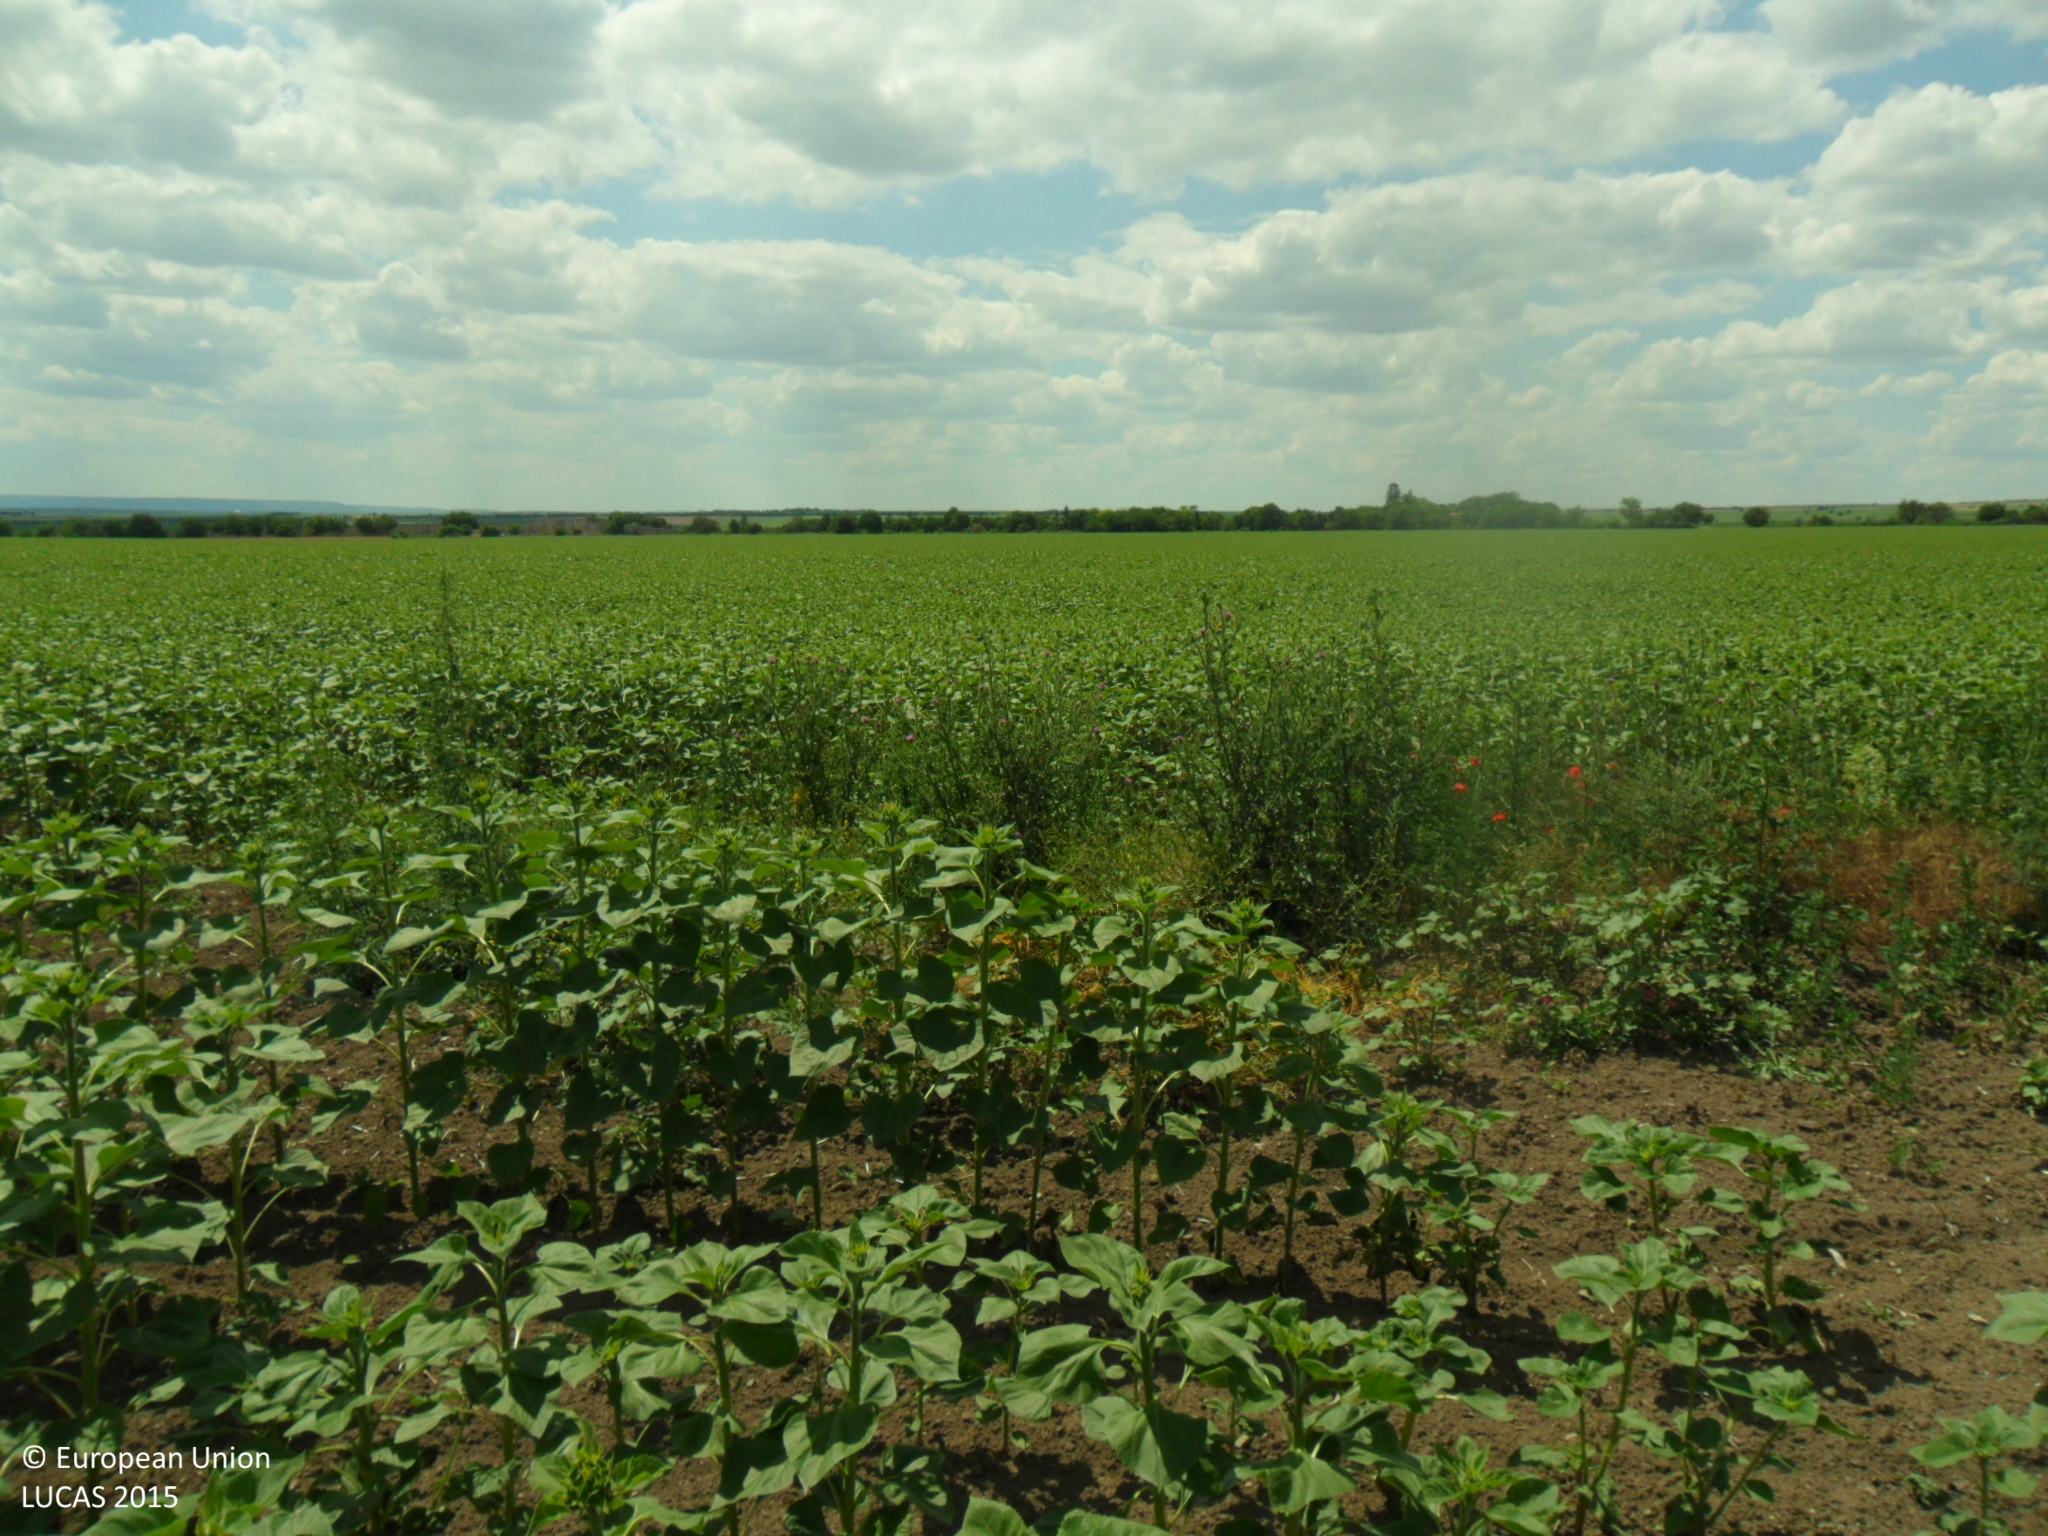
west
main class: Cropland
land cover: Sunflower
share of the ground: > 75 %
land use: Agriculture (excluding fallow land and kitchen gardens)
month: June
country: BG
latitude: 43.3894
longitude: 27.1436
